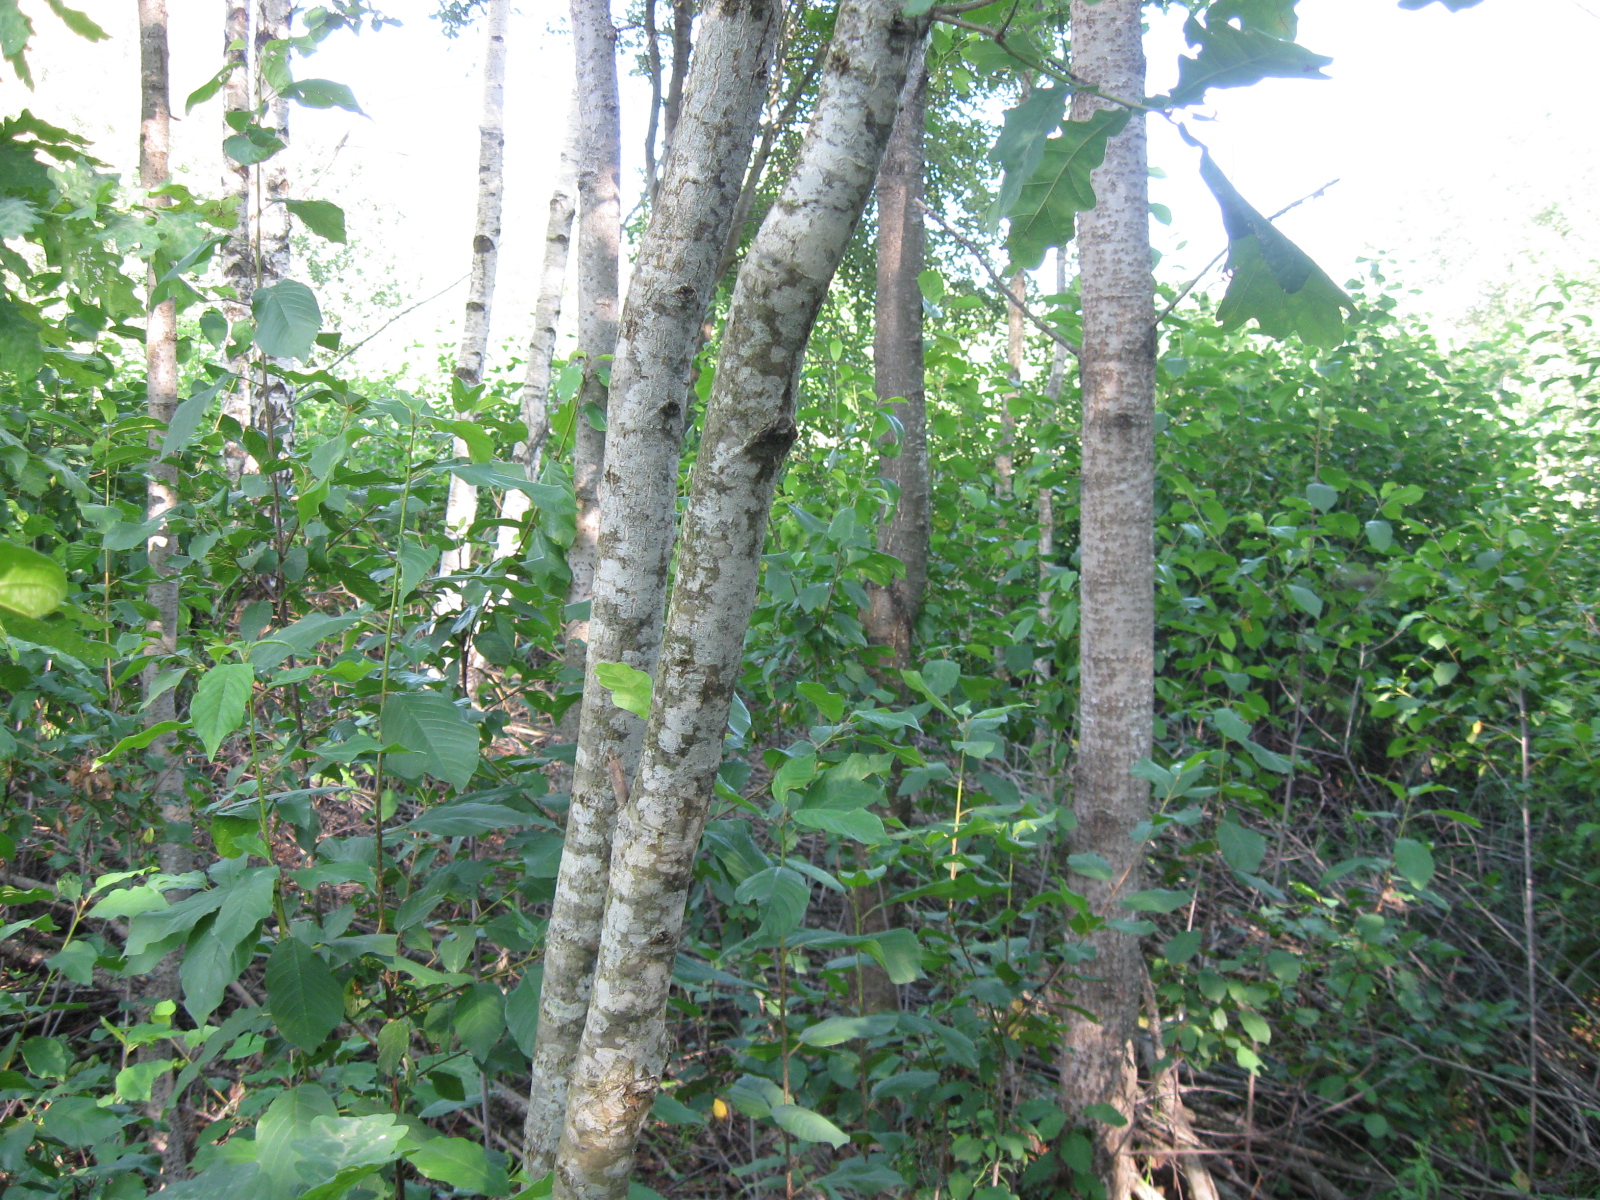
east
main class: Woodland
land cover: Broadleaved woodland
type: non-riverine alder, birch or aspen forest
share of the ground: > 75 %
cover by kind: broadleaved forest trees 90 %, herbaceous plants 10 %
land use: Forestry
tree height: > 5 m
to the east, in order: Broadleaved woodland; Grassland without tree/shrub cover; Broadleaved woodland; Grassland without tree/shrub cover; Other mixed woodland; Broadleaved woodland
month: July
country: LT
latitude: 54.4936
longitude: 24.3814
